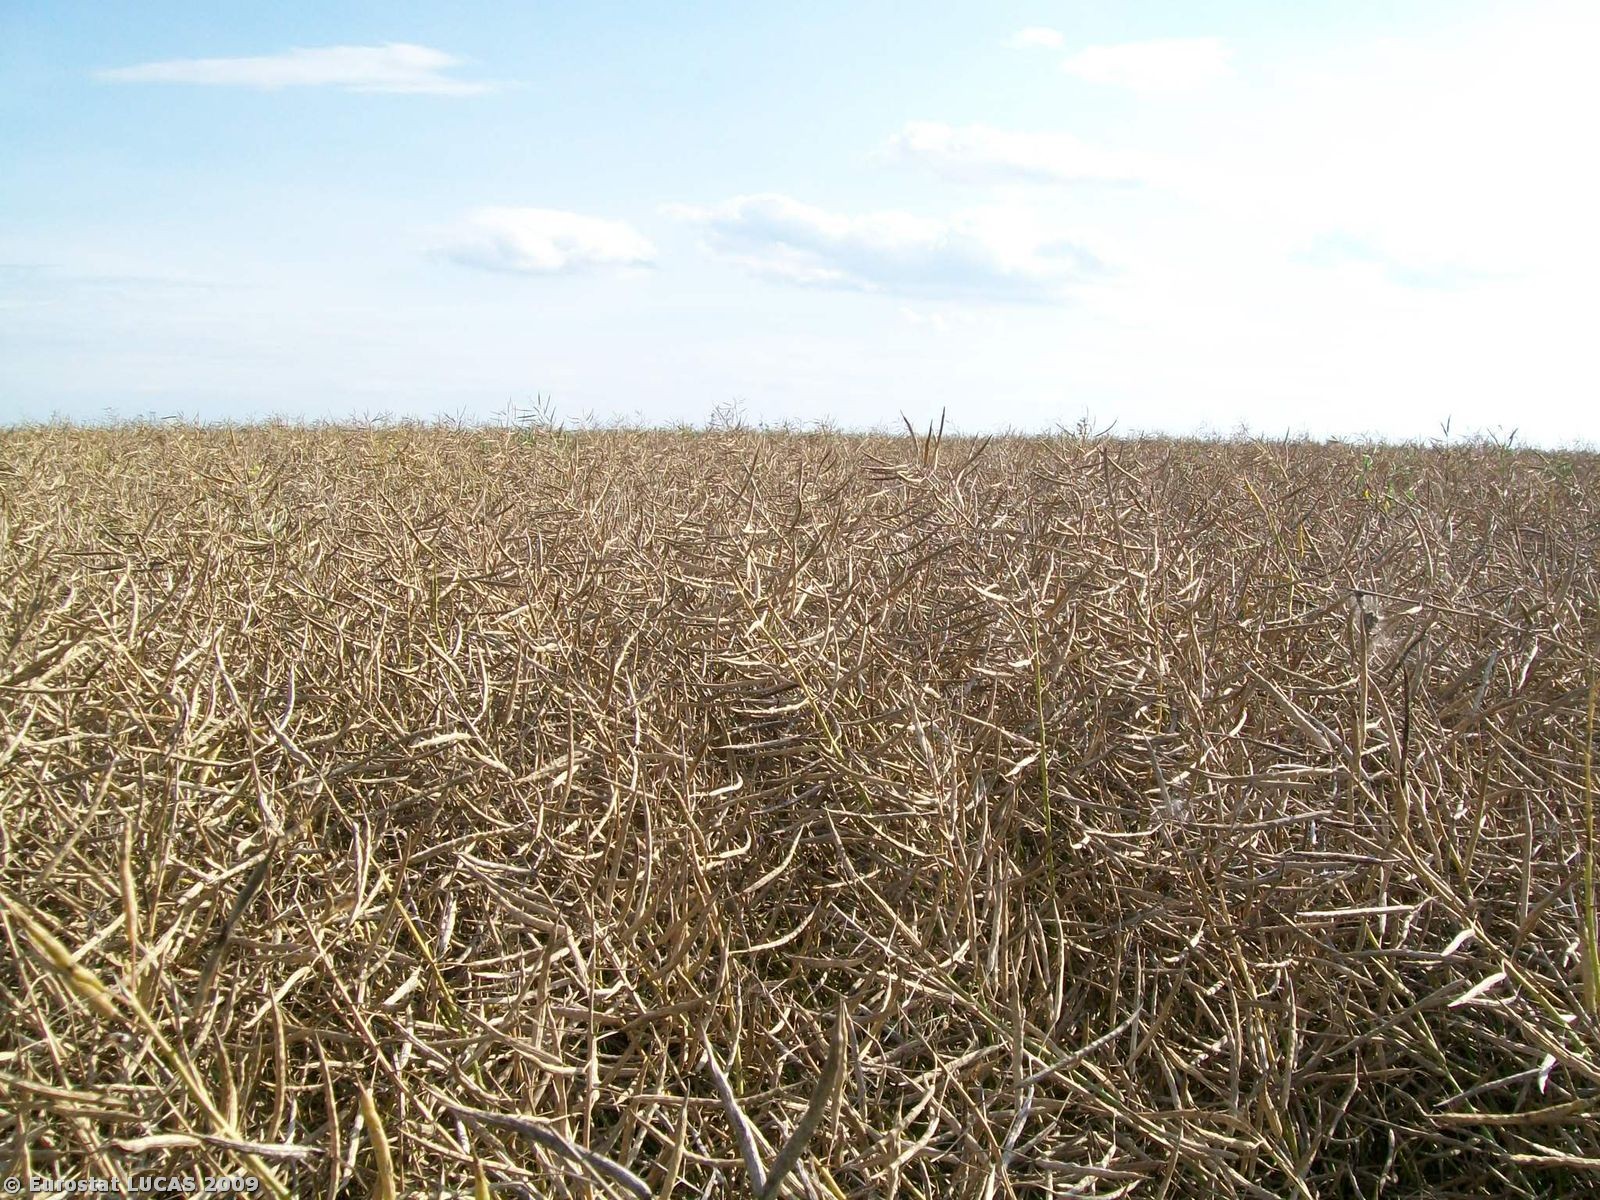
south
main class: Cropland
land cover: Rape and turnip rape
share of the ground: > 75 %
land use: Agriculture (excluding fallow land and kitchen gardens)
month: July
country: PL
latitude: 51.2140
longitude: 17.2984
